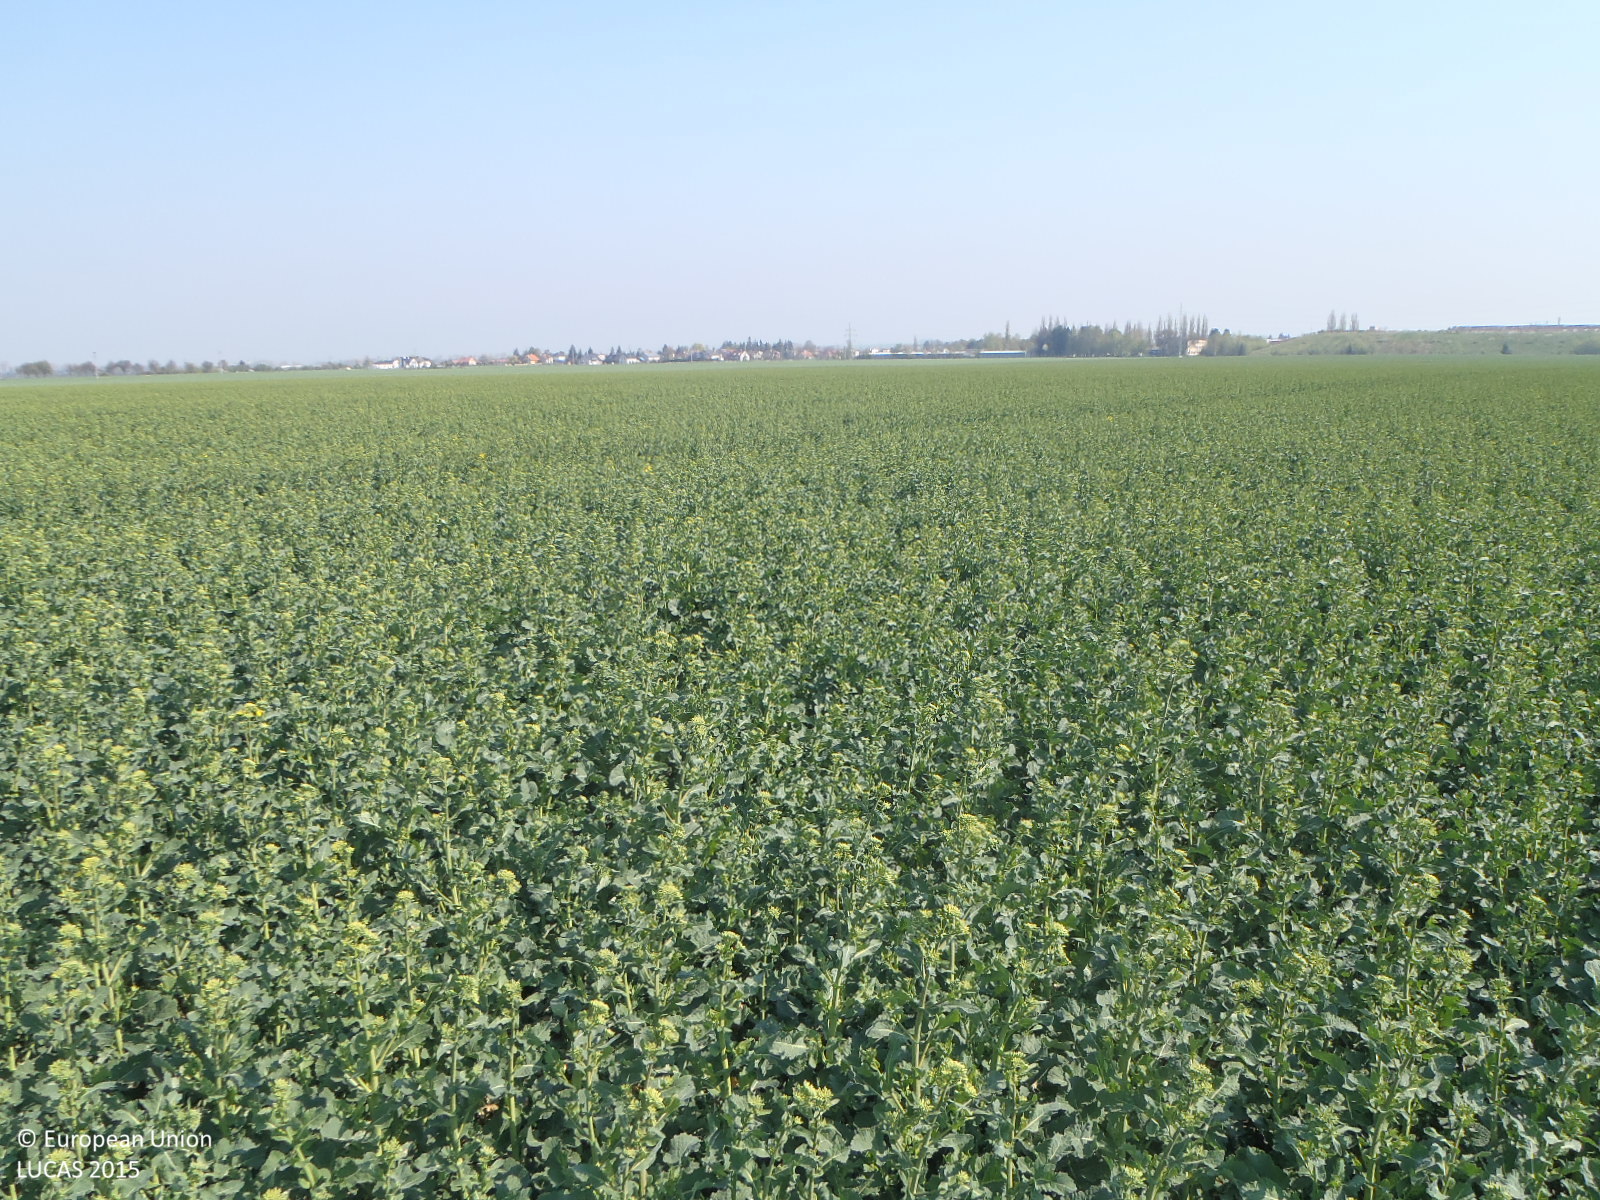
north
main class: Cropland
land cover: Rape and turnip rape
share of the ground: > 75 %
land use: Agriculture (excluding fallow land and kitchen gardens)
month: April
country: CZ
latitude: 49.5458
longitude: 17.1279
